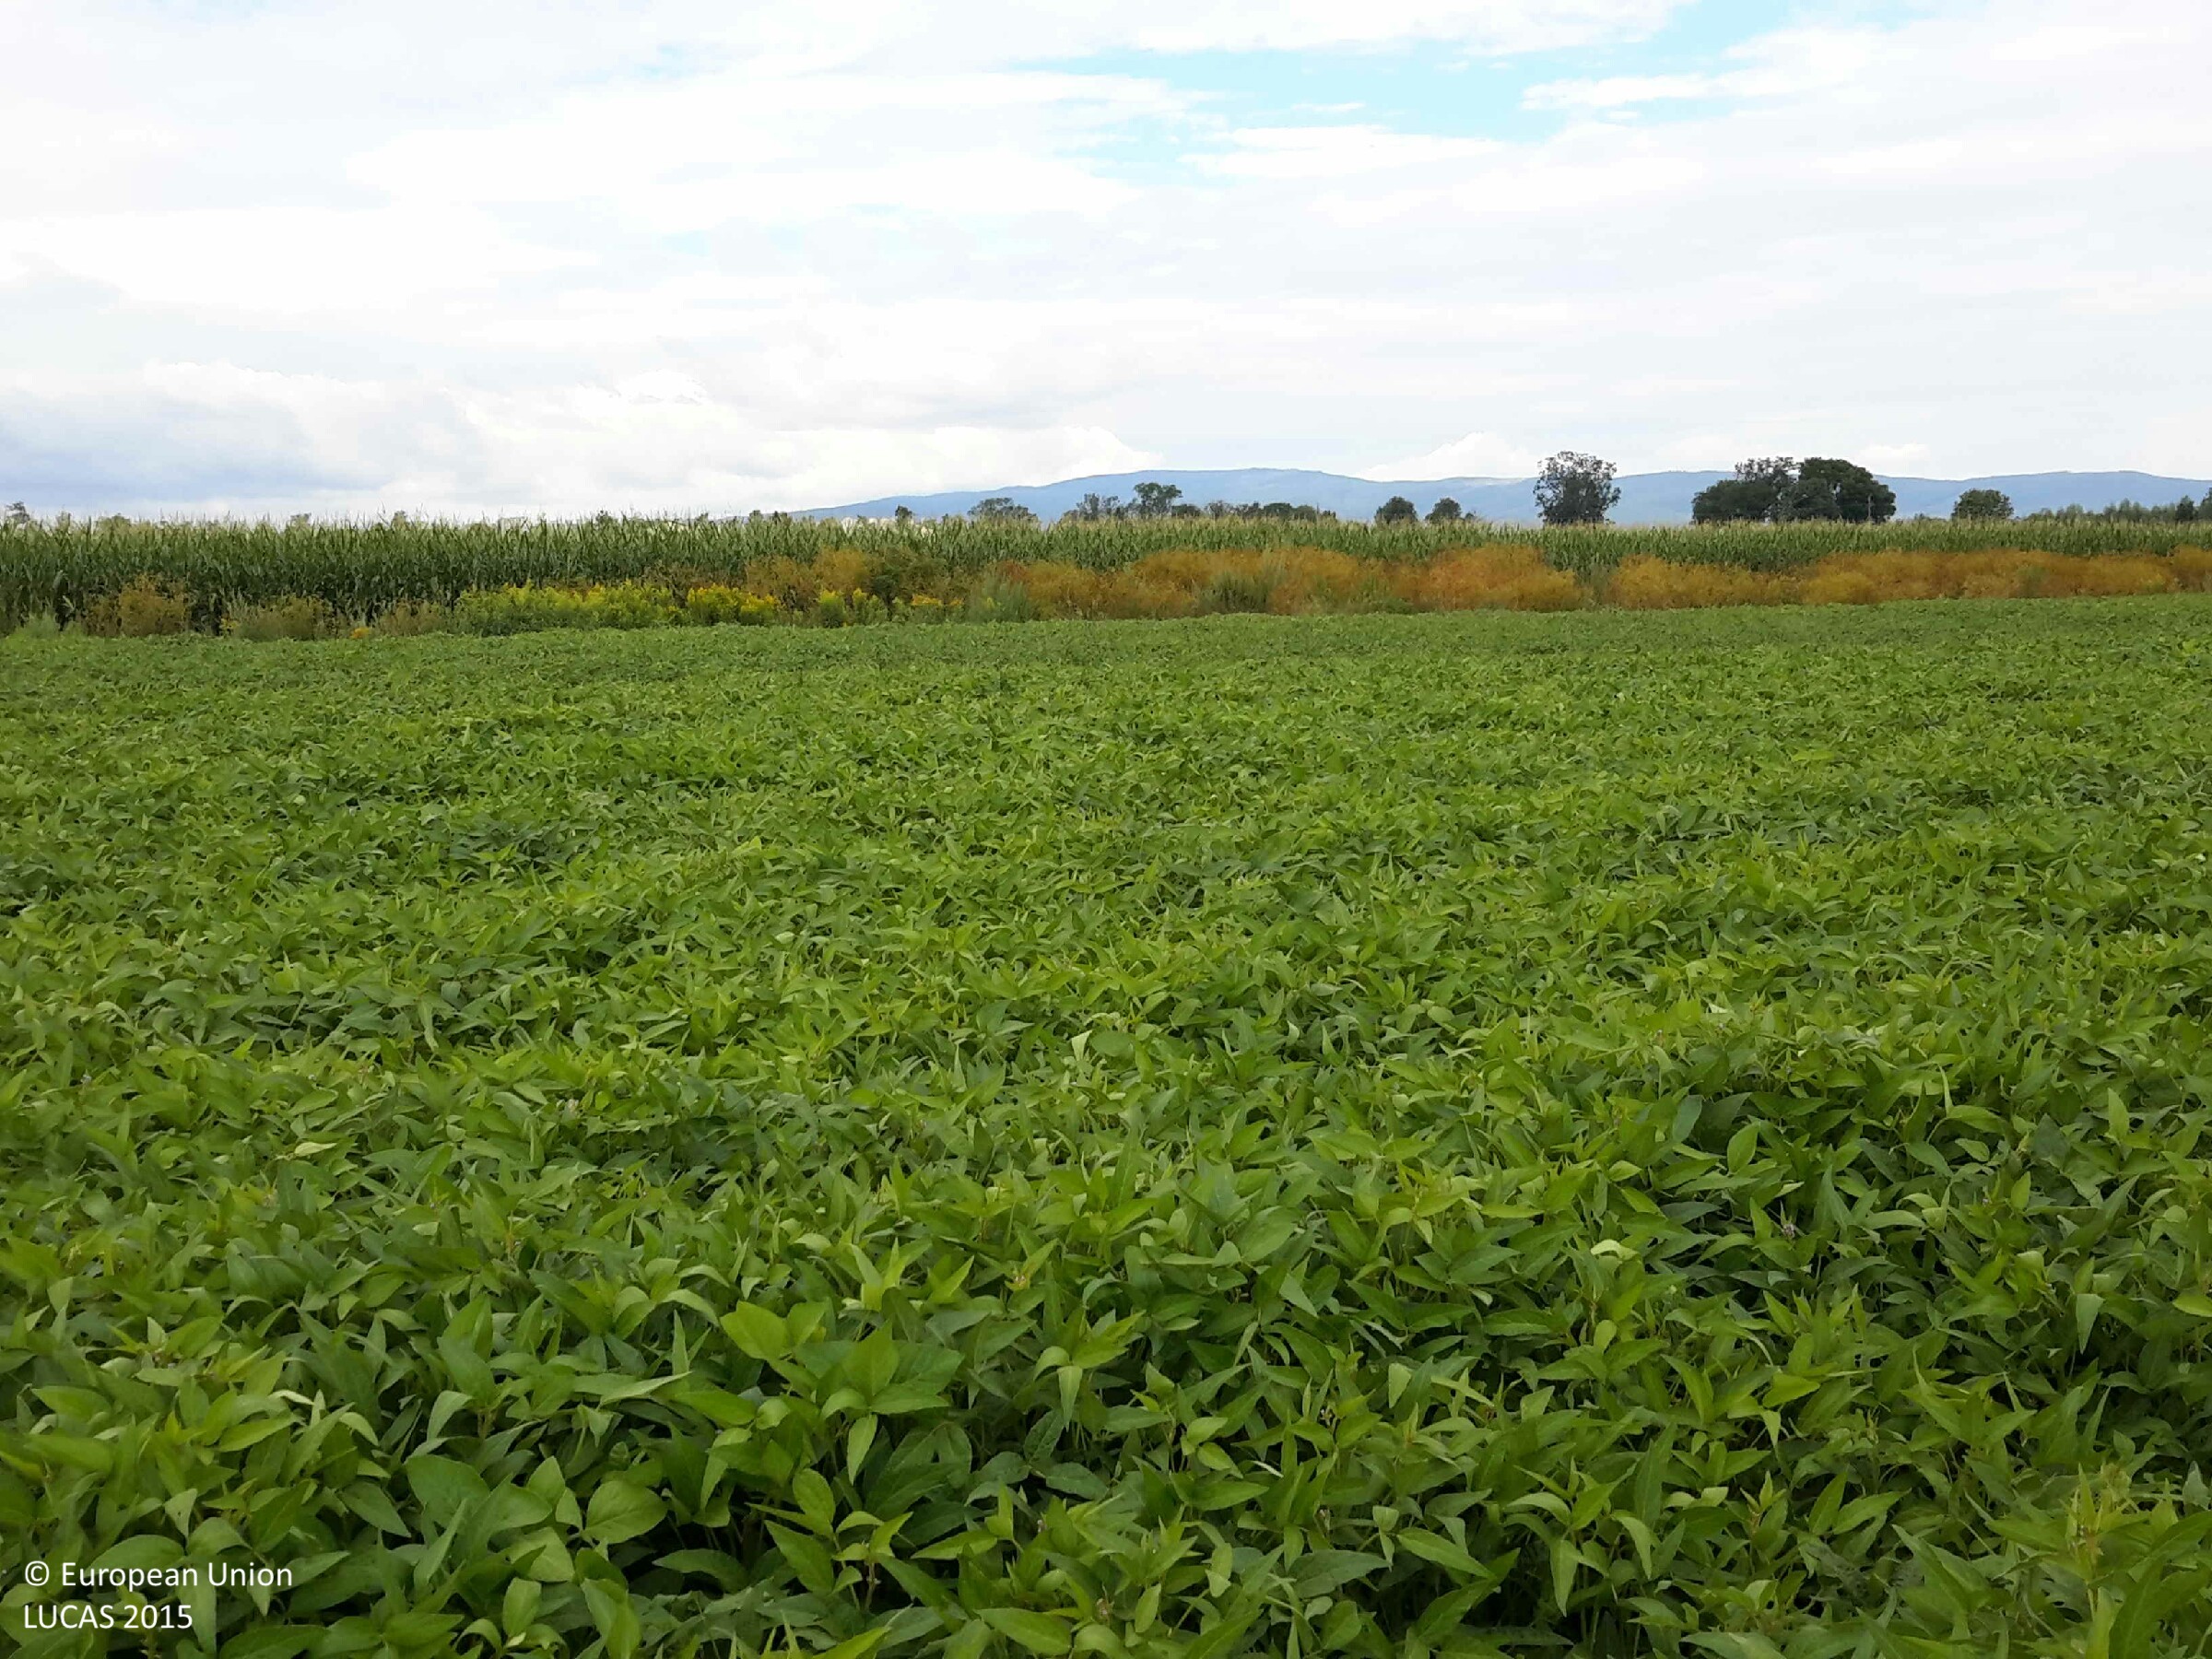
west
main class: Cropland
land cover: Soya
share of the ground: > 75 %
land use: Agriculture (excluding fallow land and kitchen gardens)
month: July
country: HU
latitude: 47.3195
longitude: 16.6321
